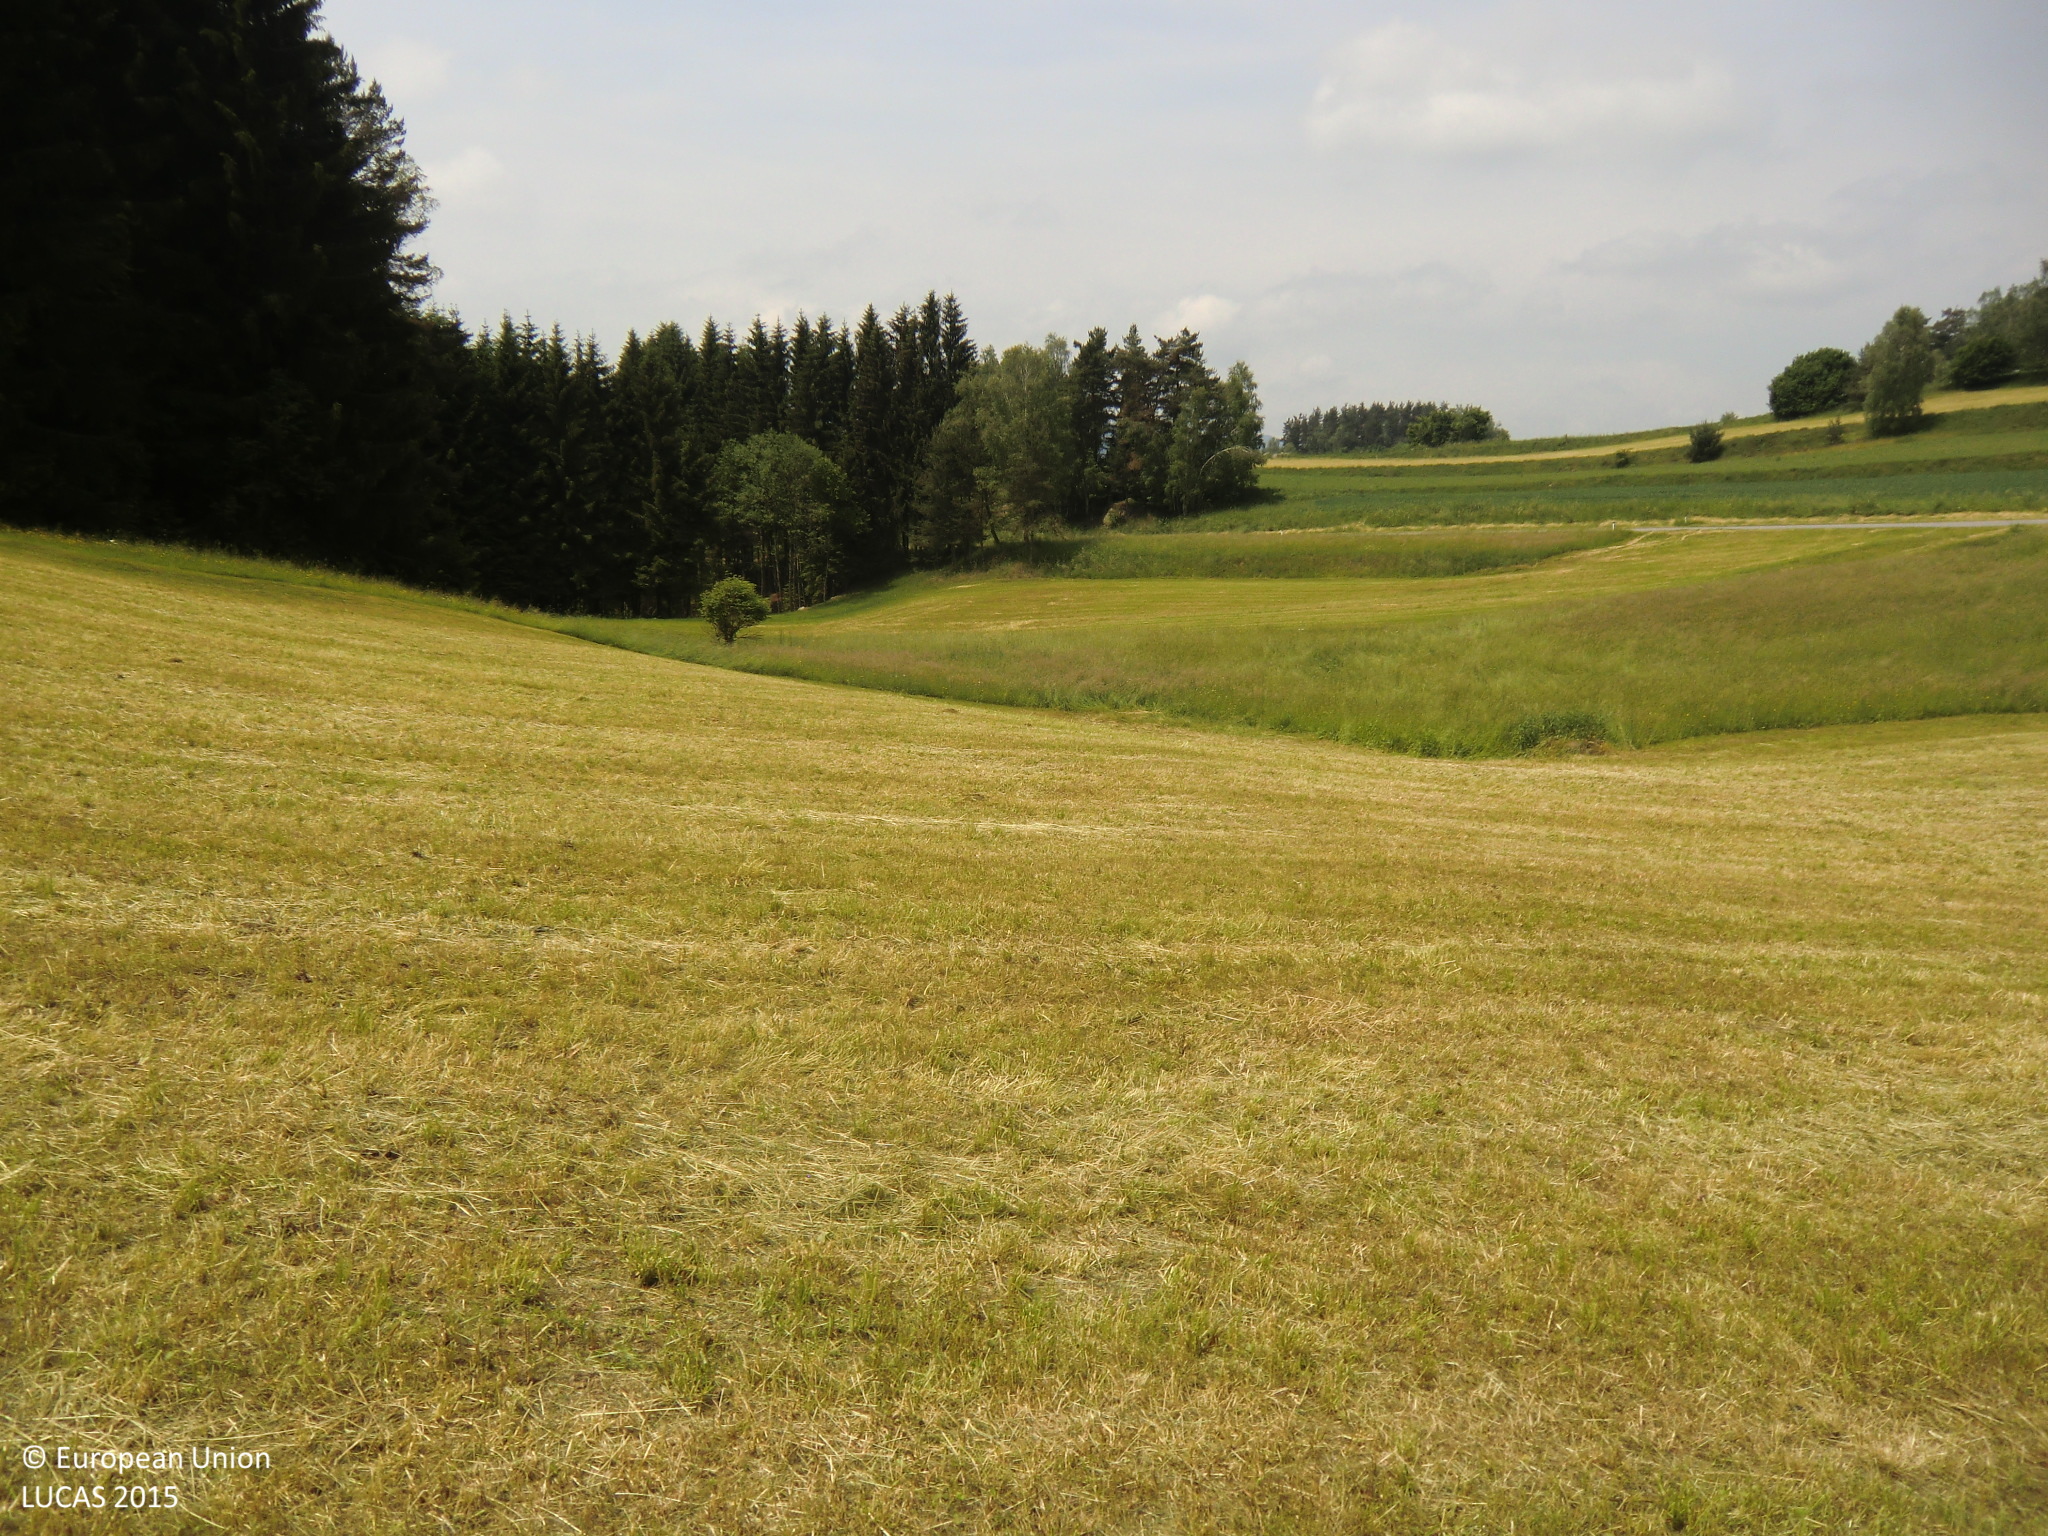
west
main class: Grassland
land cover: Grassland without tree/shrub cover
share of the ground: > 75 %
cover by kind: herbaceous plants 100 %
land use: Agriculture (excluding fallow land and kitchen gardens)
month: June
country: AT
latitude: 48.6386
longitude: 14.8734
